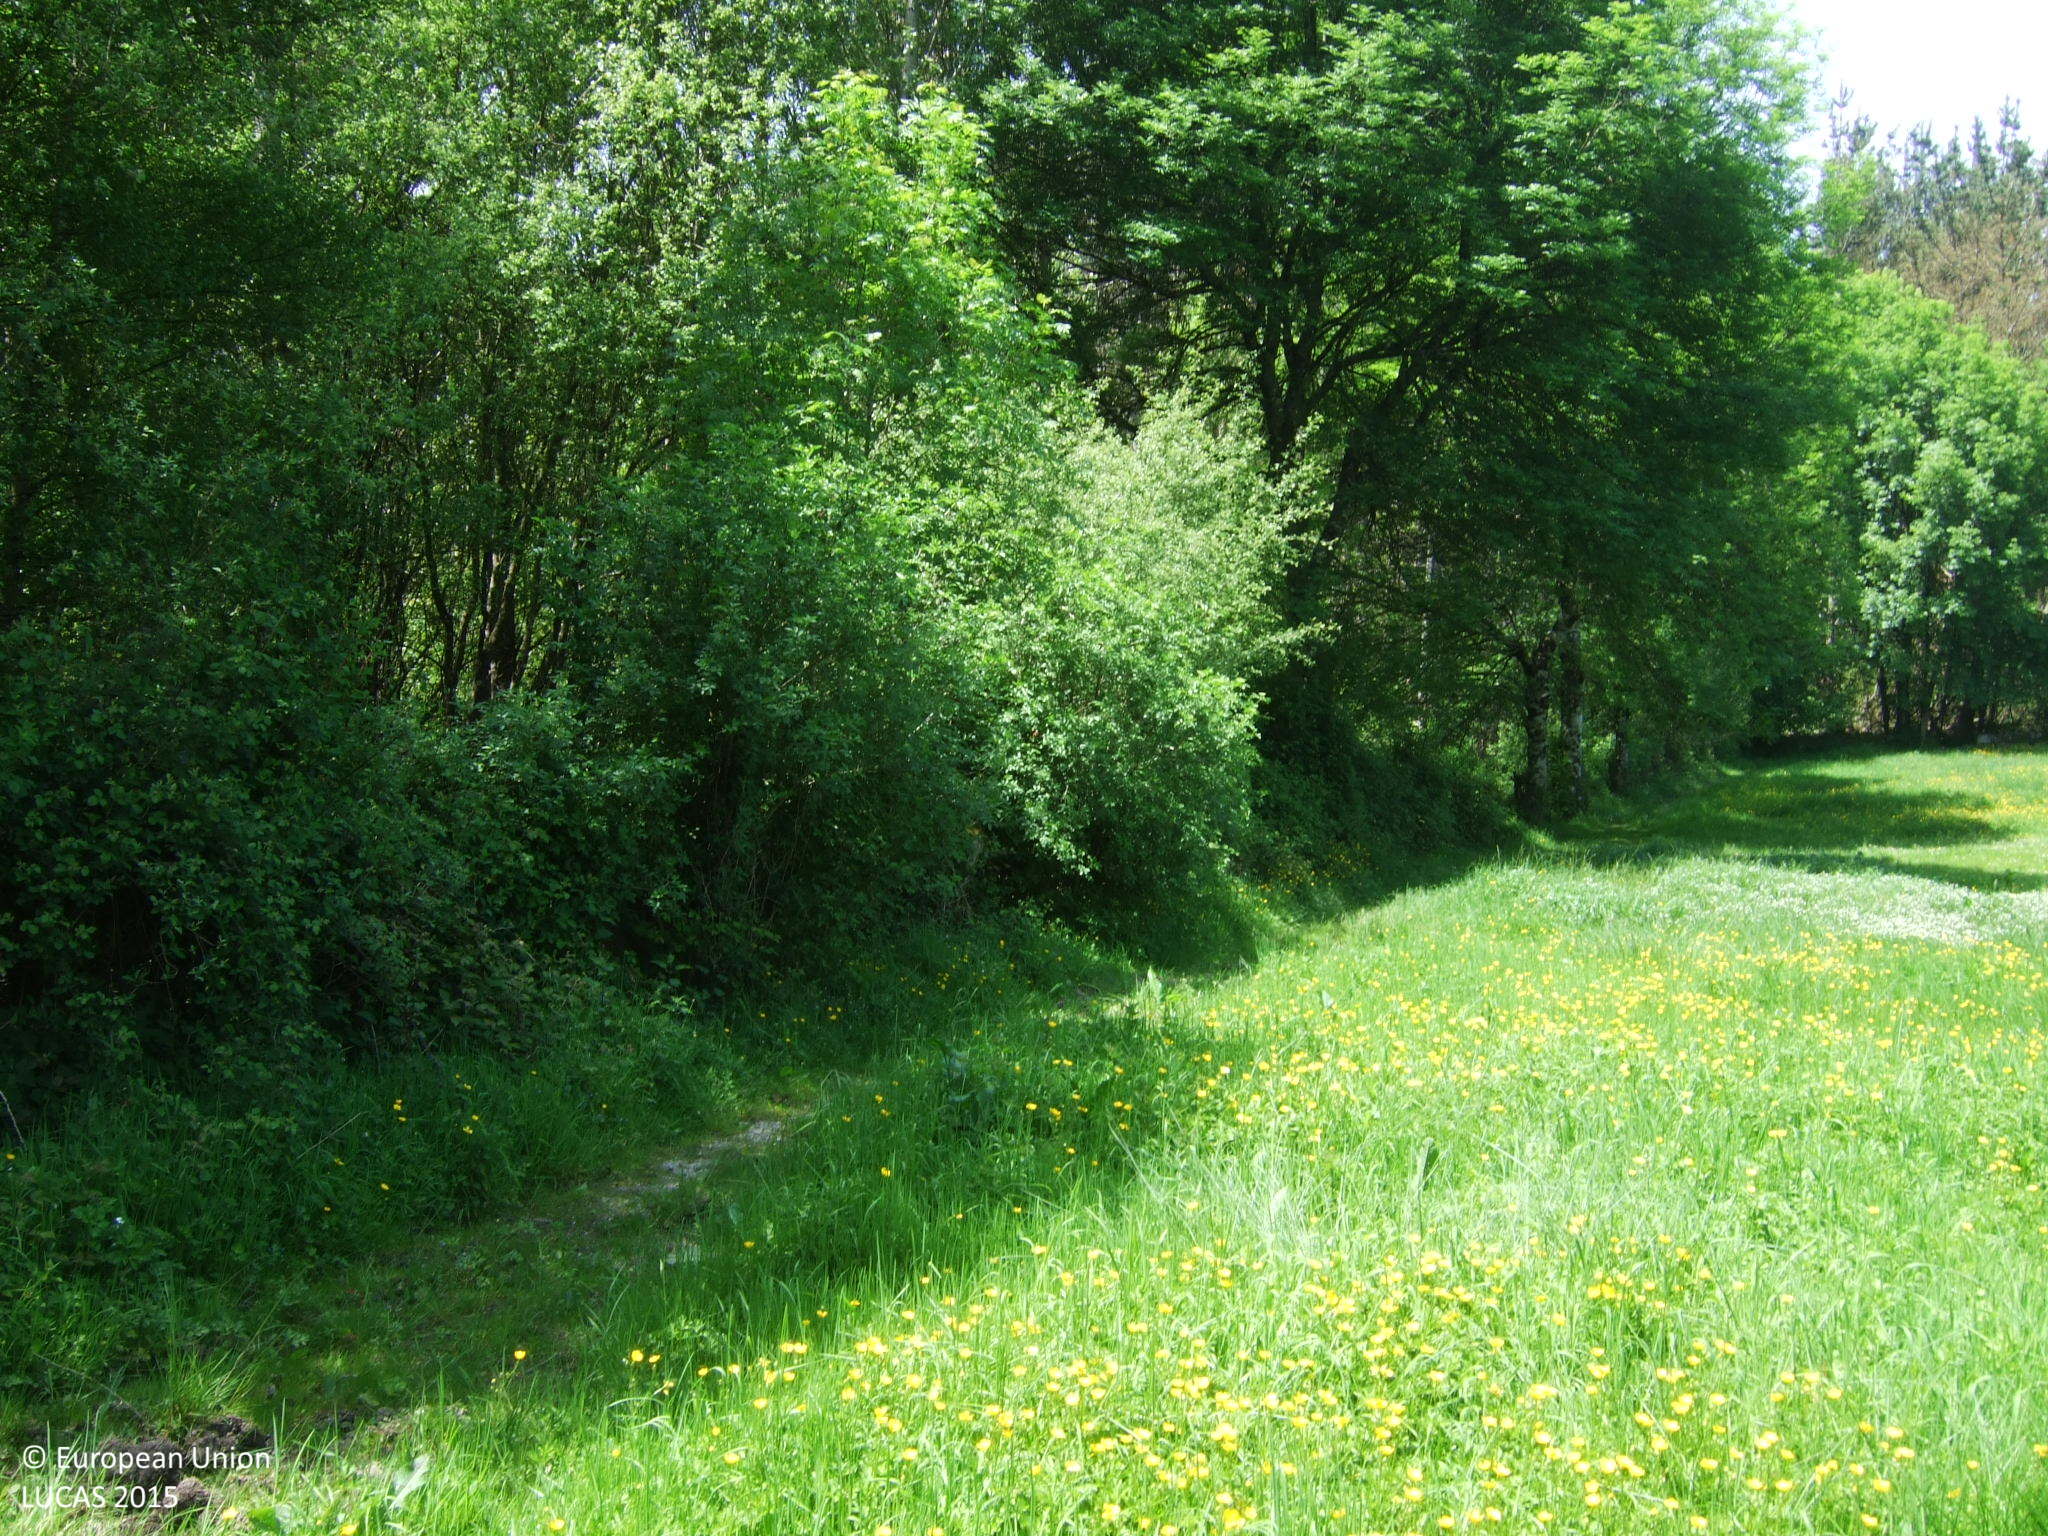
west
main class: Grassland
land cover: Grassland without tree/shrub cover
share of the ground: > 75 %
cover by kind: herbaceous plants 100 %
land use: Agriculture (excluding fallow land and kitchen gardens)
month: May
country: ES
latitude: 43.0298
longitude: -7.4148
